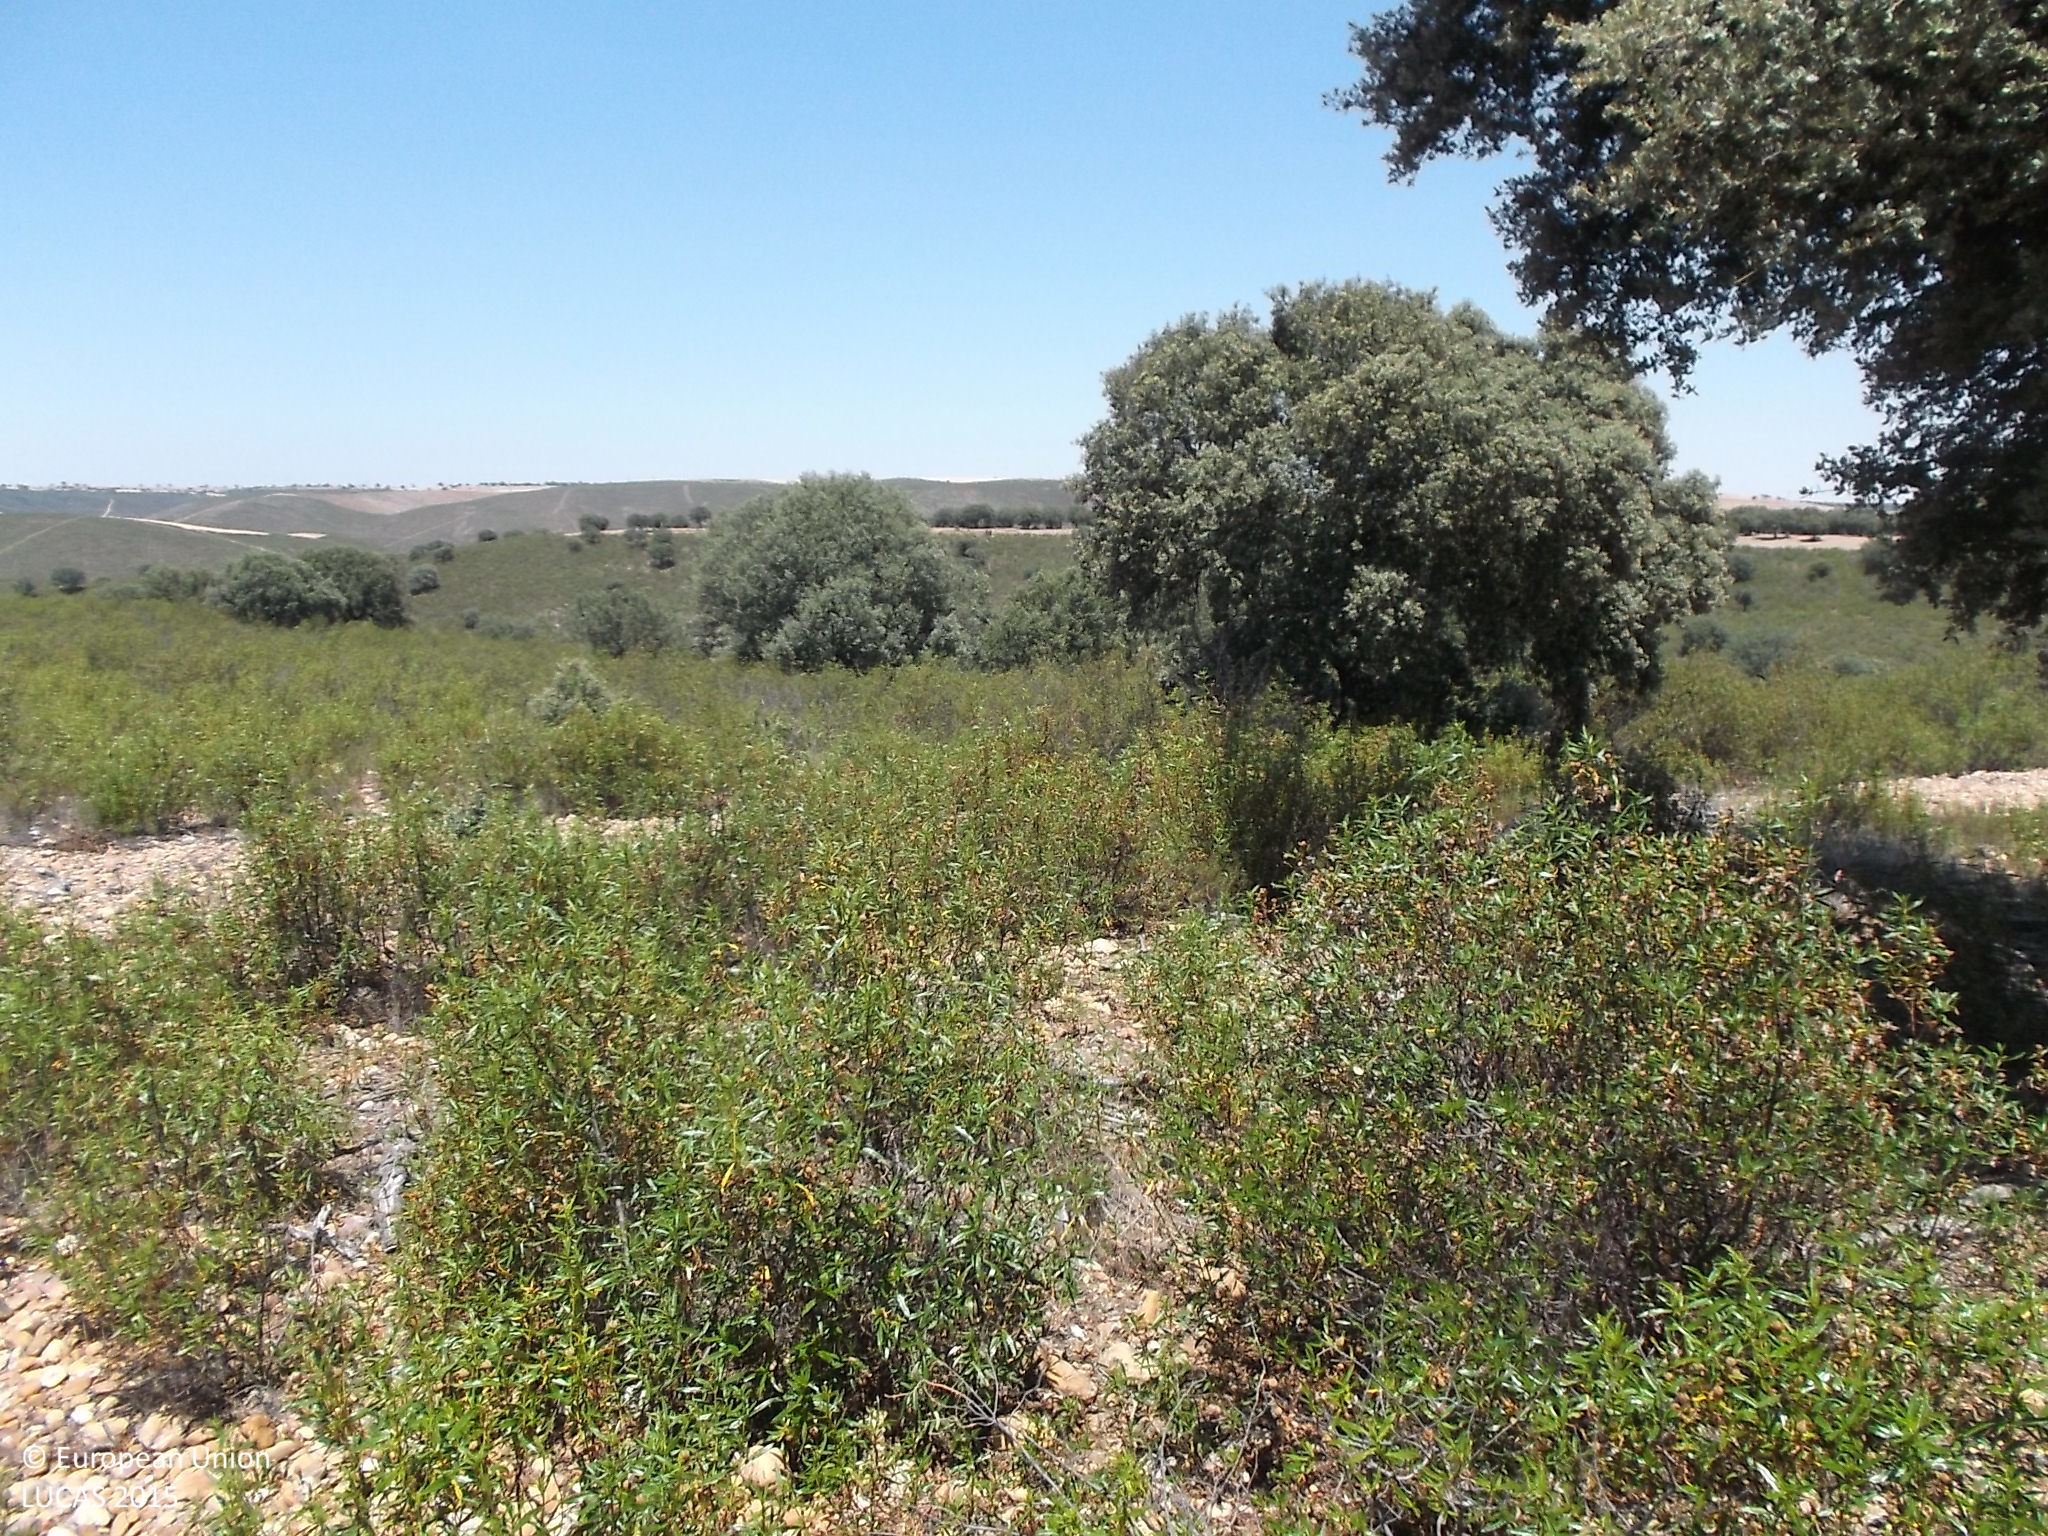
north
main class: Woodland
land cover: Broadleaved woodland
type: broadleaved evergreen forest
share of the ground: 10 - 25 %
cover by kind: unconsolidated bare surface 80 %, broadleaved forest trees 20 %
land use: Forestry
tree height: < 5 m
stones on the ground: 10 - 25 %
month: July
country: ES
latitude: 41.5042
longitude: -5.8670
